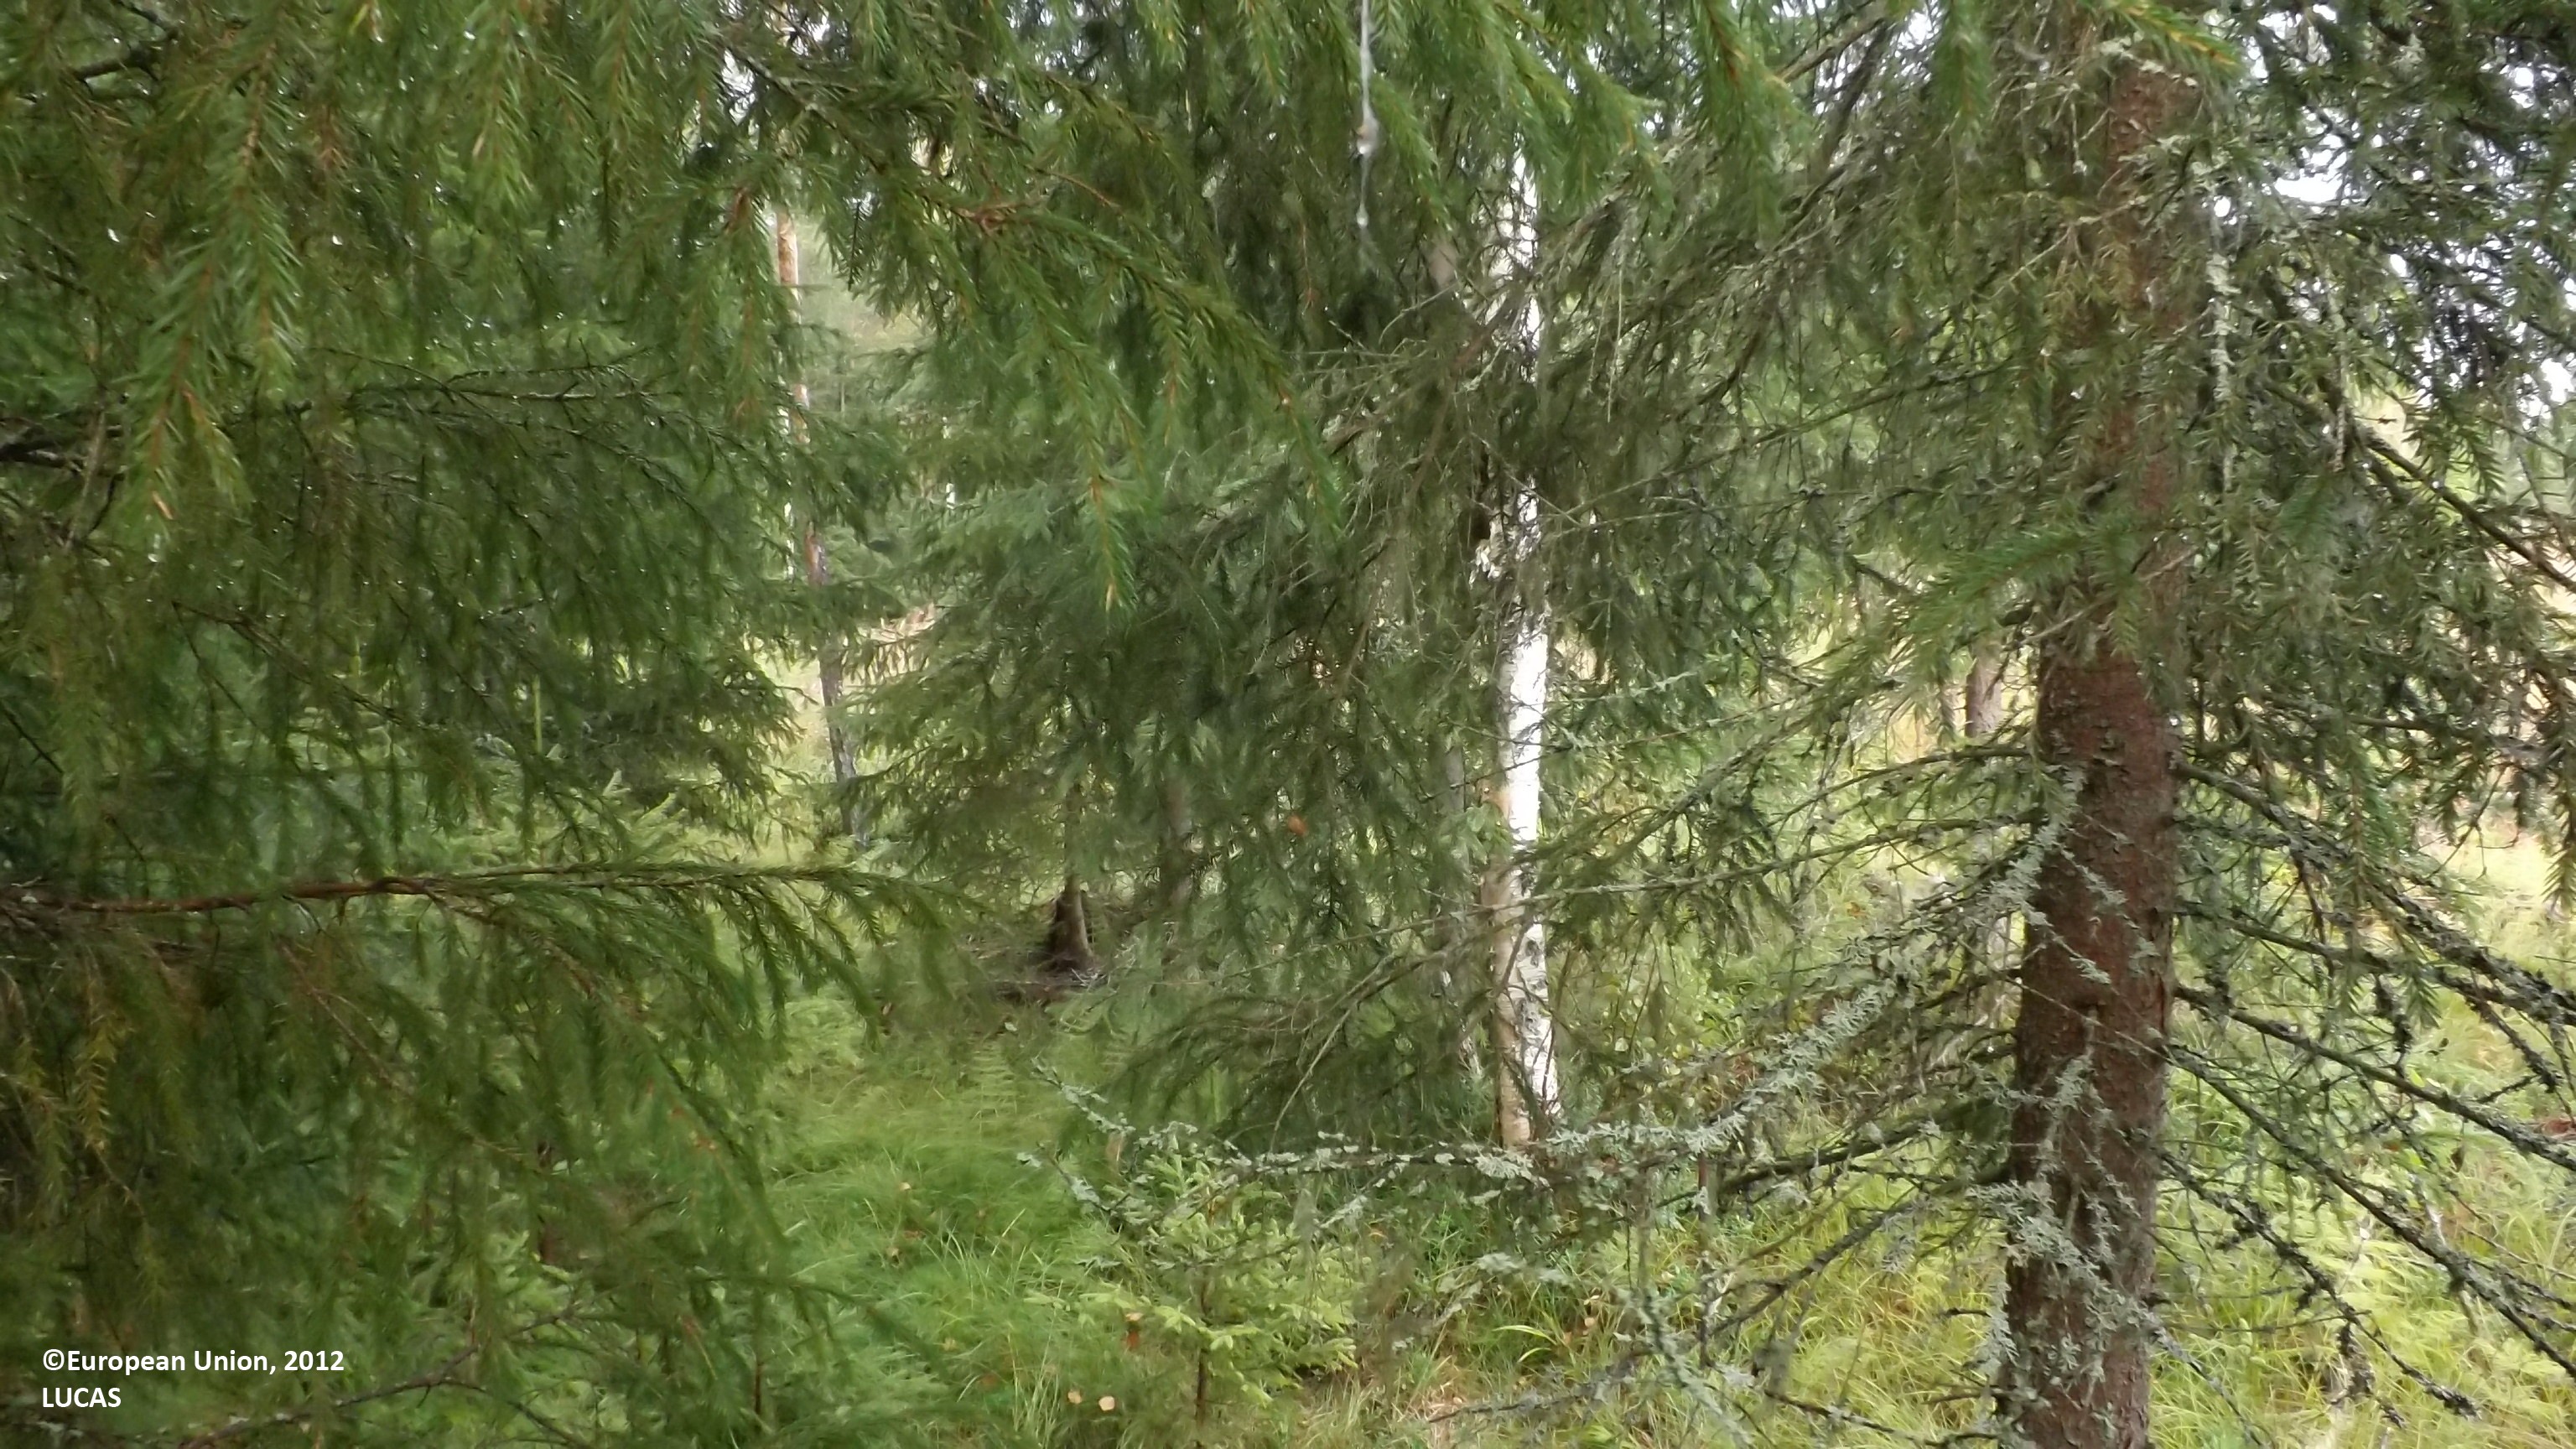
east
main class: Woodland
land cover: Spruce dominated mixed woodland
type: boreal forest
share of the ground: > 75 %
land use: Forestry
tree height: > 5 m
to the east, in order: Spruce dominated mixed woodland; Shrubland without tree cover; Ditches and canals; Other mixed woodland; Pine dominated mixed woodland; Ditches and canals; Spruce dominated coniferous woodland; Ditches and canals; Spruce dominated mixed woodland; Other coniferous woodland; Spruce dominated mixed woodland; Ditches and canals; Spruce dominated mixed woodland; Pine dominated mixed woodland; Ditches and canals; Pine dominated mixed woodland
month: August
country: FI
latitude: 63.9710
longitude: 23.8498
